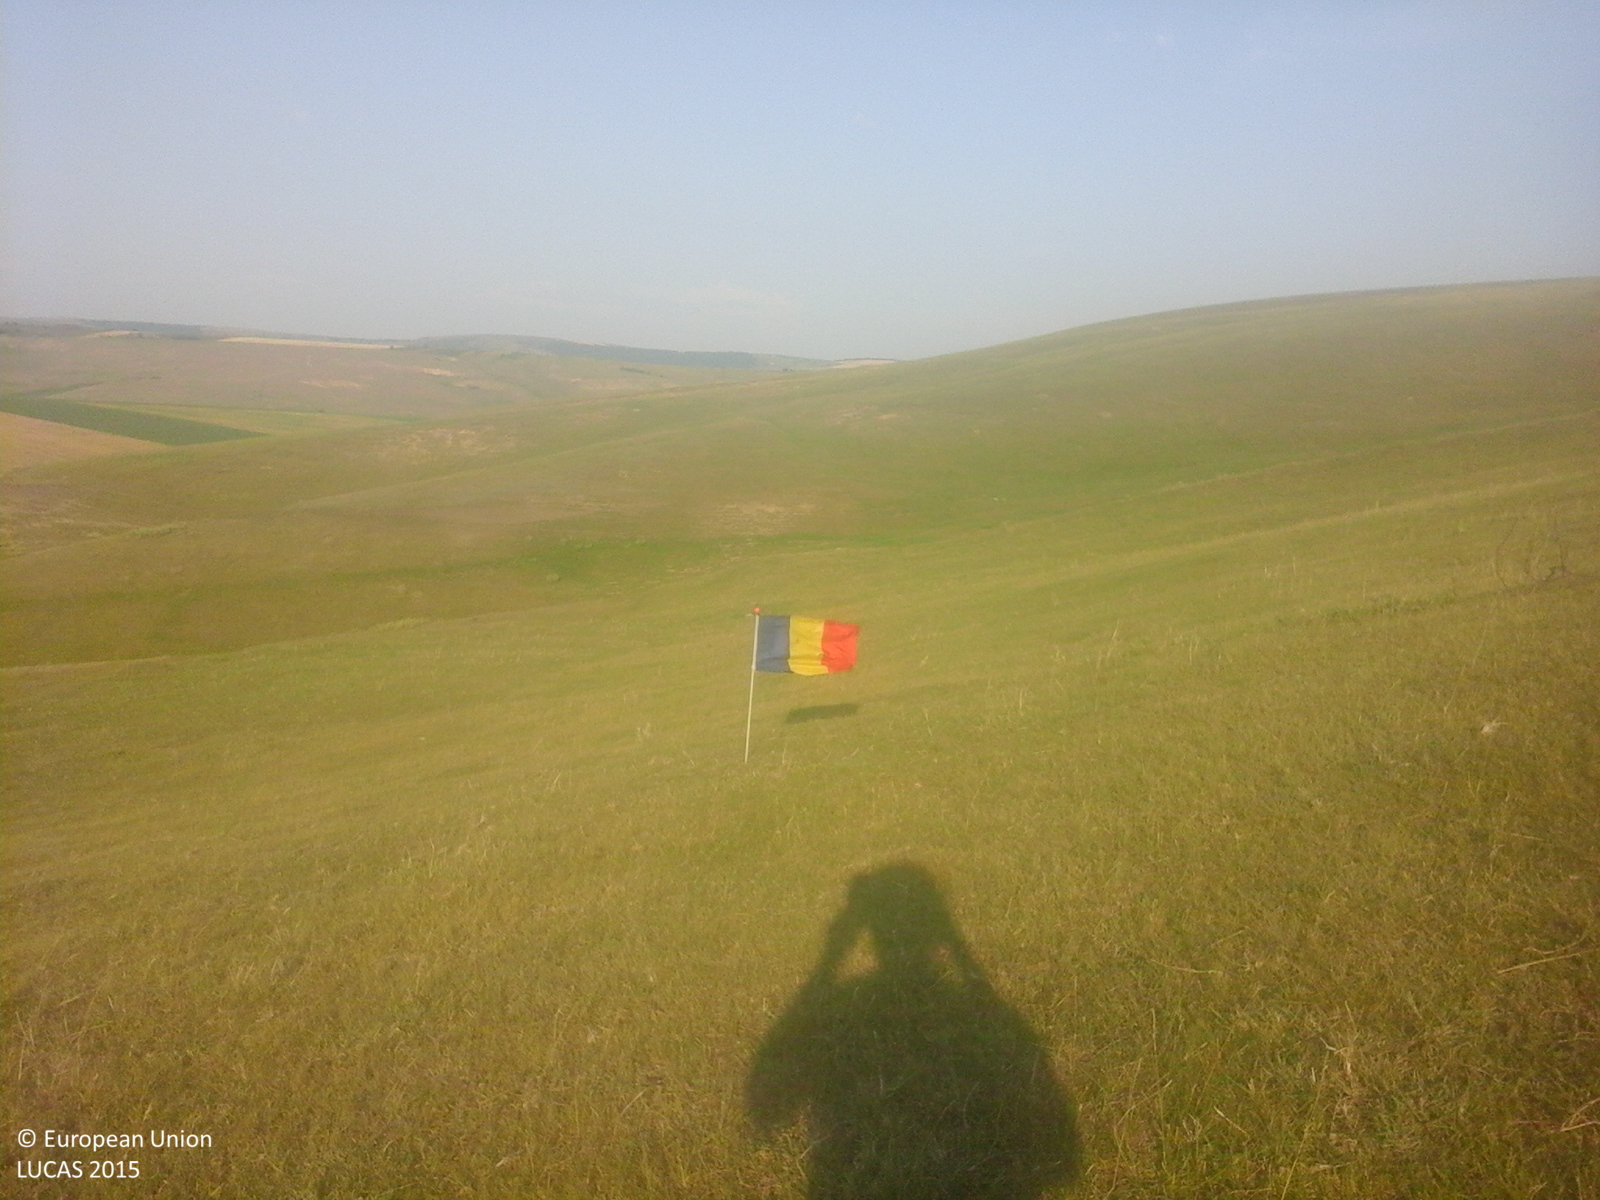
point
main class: Grassland
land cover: Grassland without tree/shrub cover
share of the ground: > 75 %
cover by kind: herbaceous plants 100 %
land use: Agriculture (excluding fallow land and kitchen gardens)
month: June
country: RO
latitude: 46.7354
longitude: 27.7211
